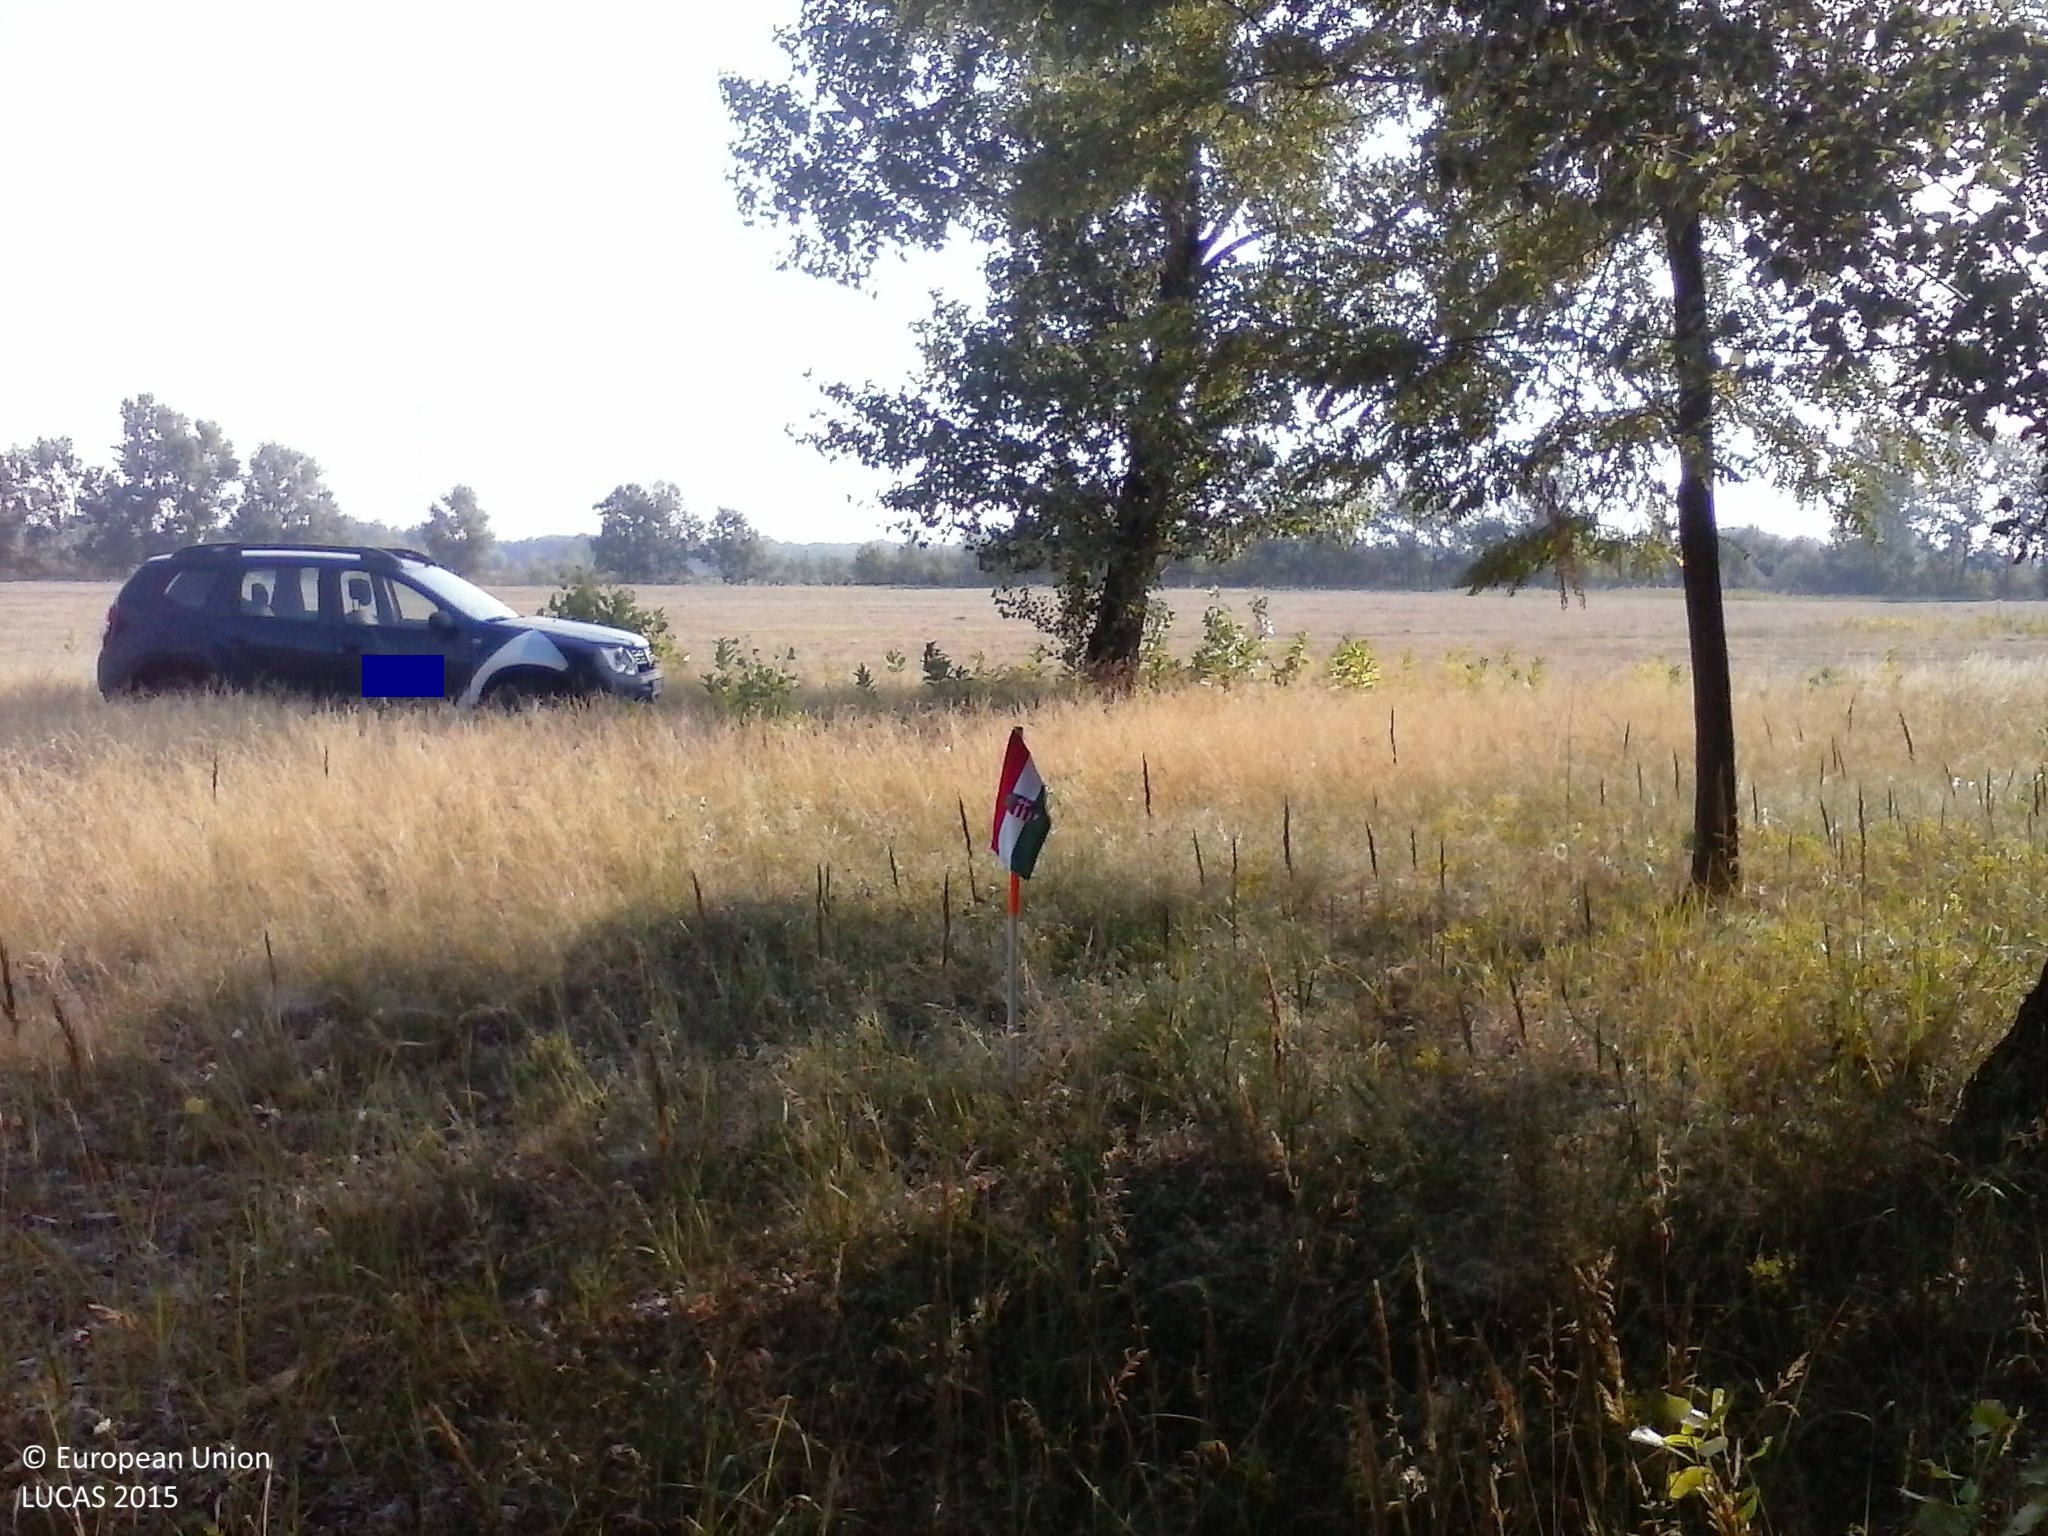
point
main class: Woodland
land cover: Broadleaved woodland
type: mesophytic deciduous forest
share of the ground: 25 - 50 %
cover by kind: herbaceous plants 70 %, broadleaved forest trees 25 %, shrubs 5 %
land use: Forestry
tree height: > 5 m
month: July
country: HU
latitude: 46.4006
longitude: 19.6824
